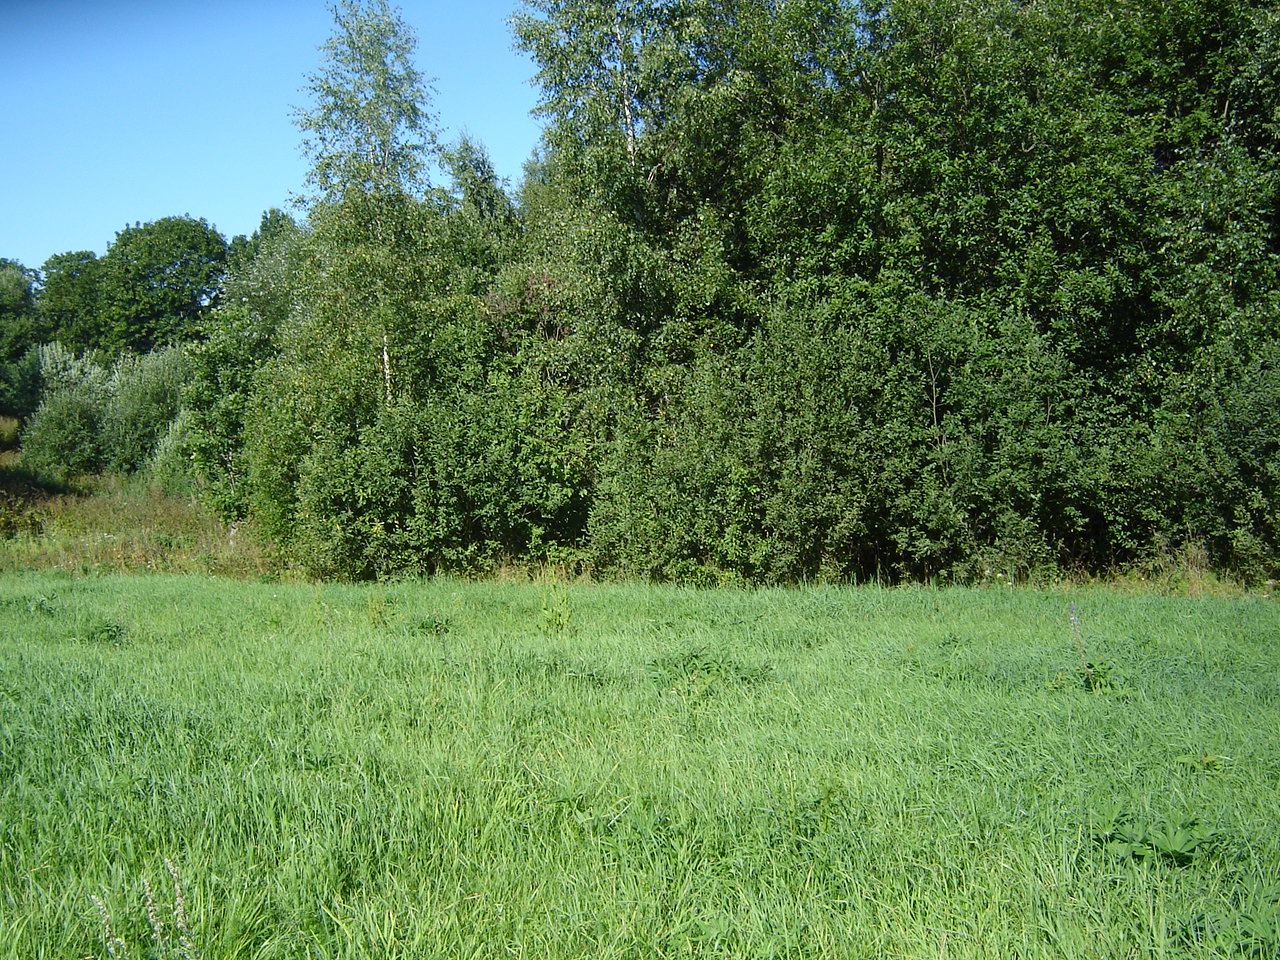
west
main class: Grassland
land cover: Grassland without tree/shrub cover
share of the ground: > 75 %
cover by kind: herbaceous plants 100 %
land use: Agriculture (excluding fallow land and kitchen gardens)
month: August
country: LT
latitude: 54.9763
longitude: 25.3876
